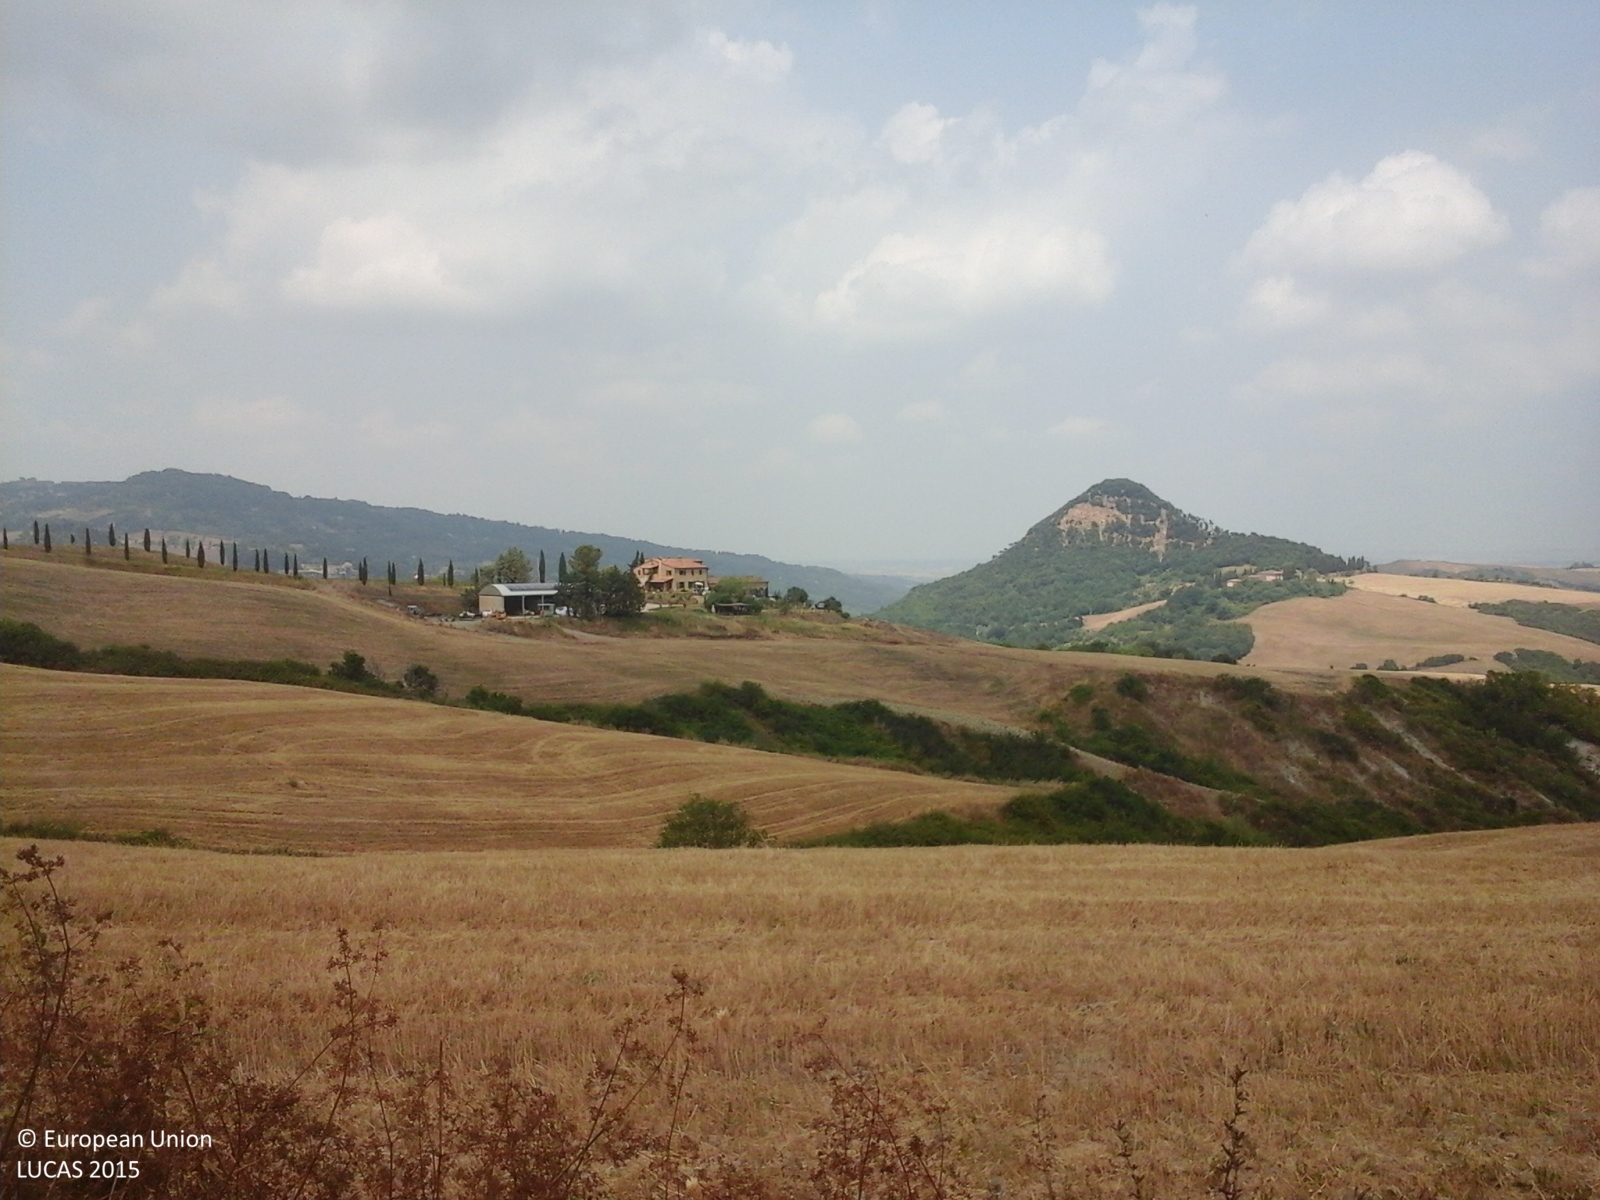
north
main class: Woodland
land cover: Broadleaved woodland
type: thermophilous deciduous forest
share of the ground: > 75 %
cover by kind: broadleaved forest trees 100 %
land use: Forestry
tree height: > 5 m
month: July
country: IT
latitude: 43.3901
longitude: 10.9232
